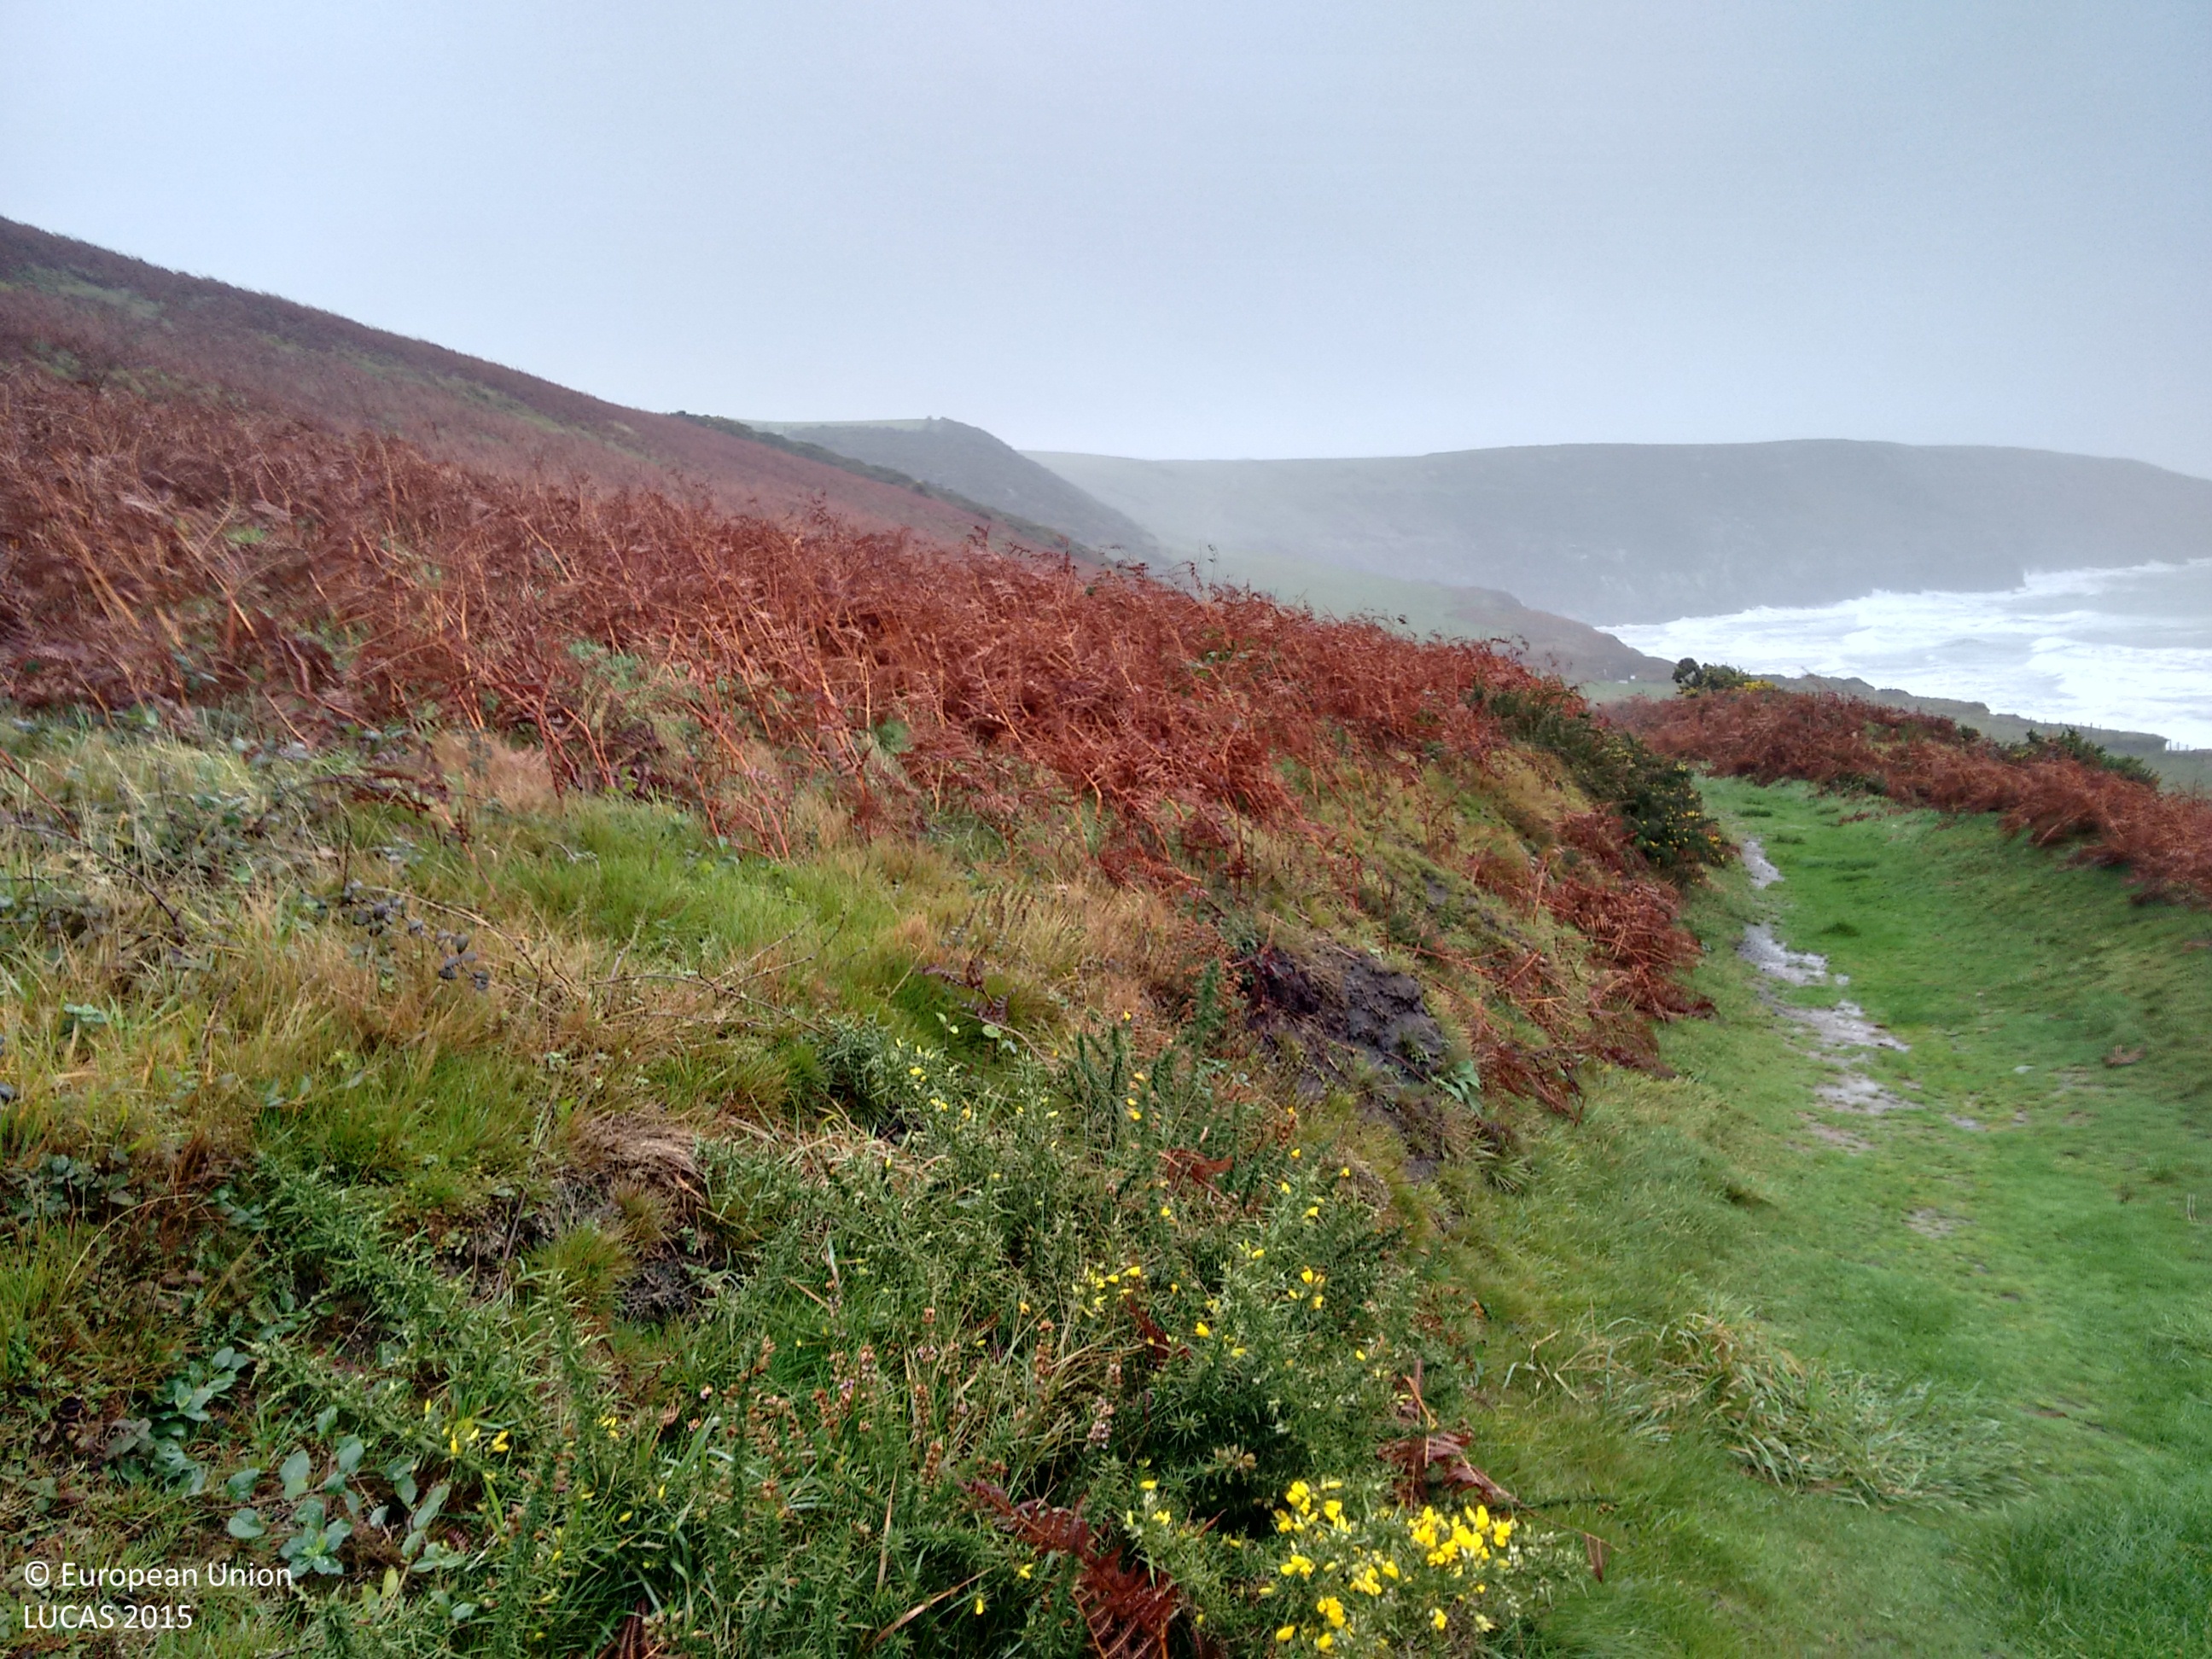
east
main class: Shrubland
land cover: Shrubland without tree cover
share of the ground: > 75 %
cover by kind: shrubs 80 %, herbaceous plants 20 %
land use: Agriculture (excluding fallow land and kitchen gardens)
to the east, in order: Shrubland without tree cover; Tracks; Shrubland without tree cover; Fences; Shrubland without tree cover; Tracks; Shrubland without tree cover
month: November
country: GB
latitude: 52.7962
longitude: -4.5061
